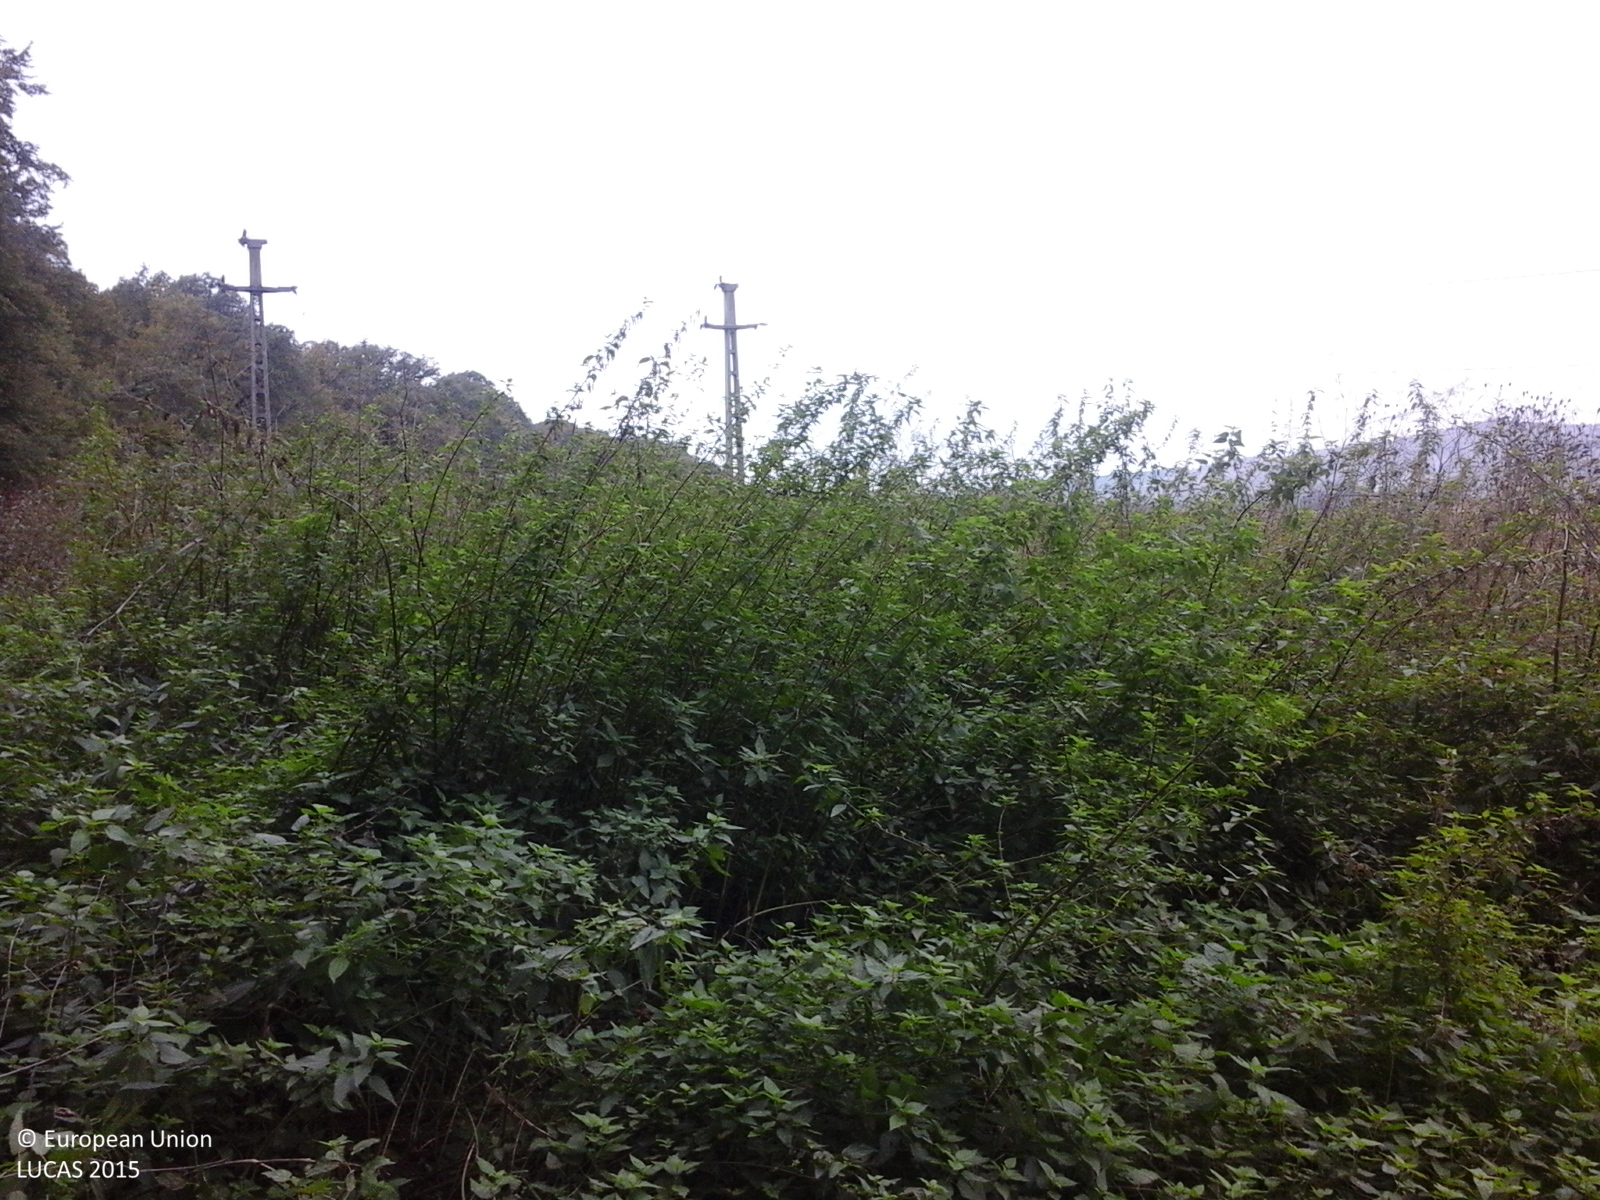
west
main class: Woodland
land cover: Broadleaved woodland
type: mesophytic deciduous forest
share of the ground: > 75 %
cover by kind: broadleaved forest trees 100 %
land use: Forestry
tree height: > 5 m
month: October
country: RO
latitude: 46.7744
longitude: 24.8289
